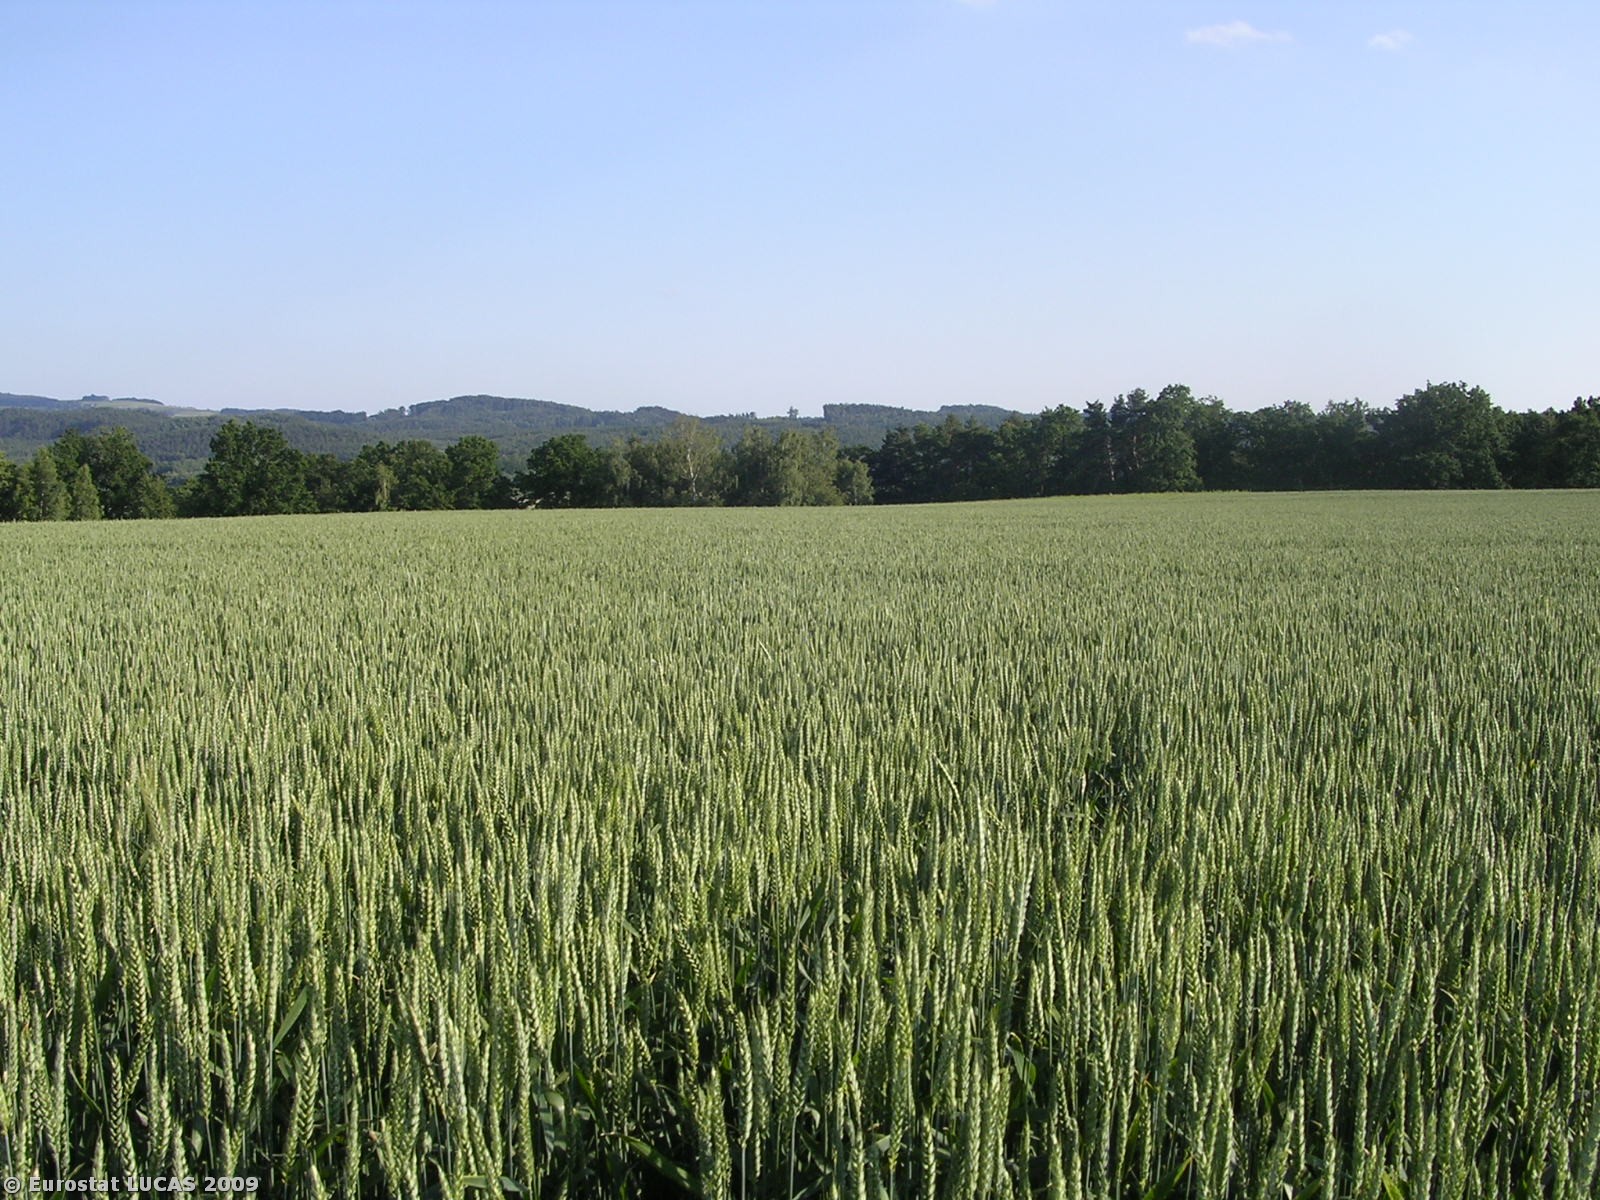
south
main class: Cropland
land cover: Common wheat
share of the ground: > 75 %
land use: Agriculture (excluding fallow land and kitchen gardens)
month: June
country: CZ
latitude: 50.6341
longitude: 14.5404
